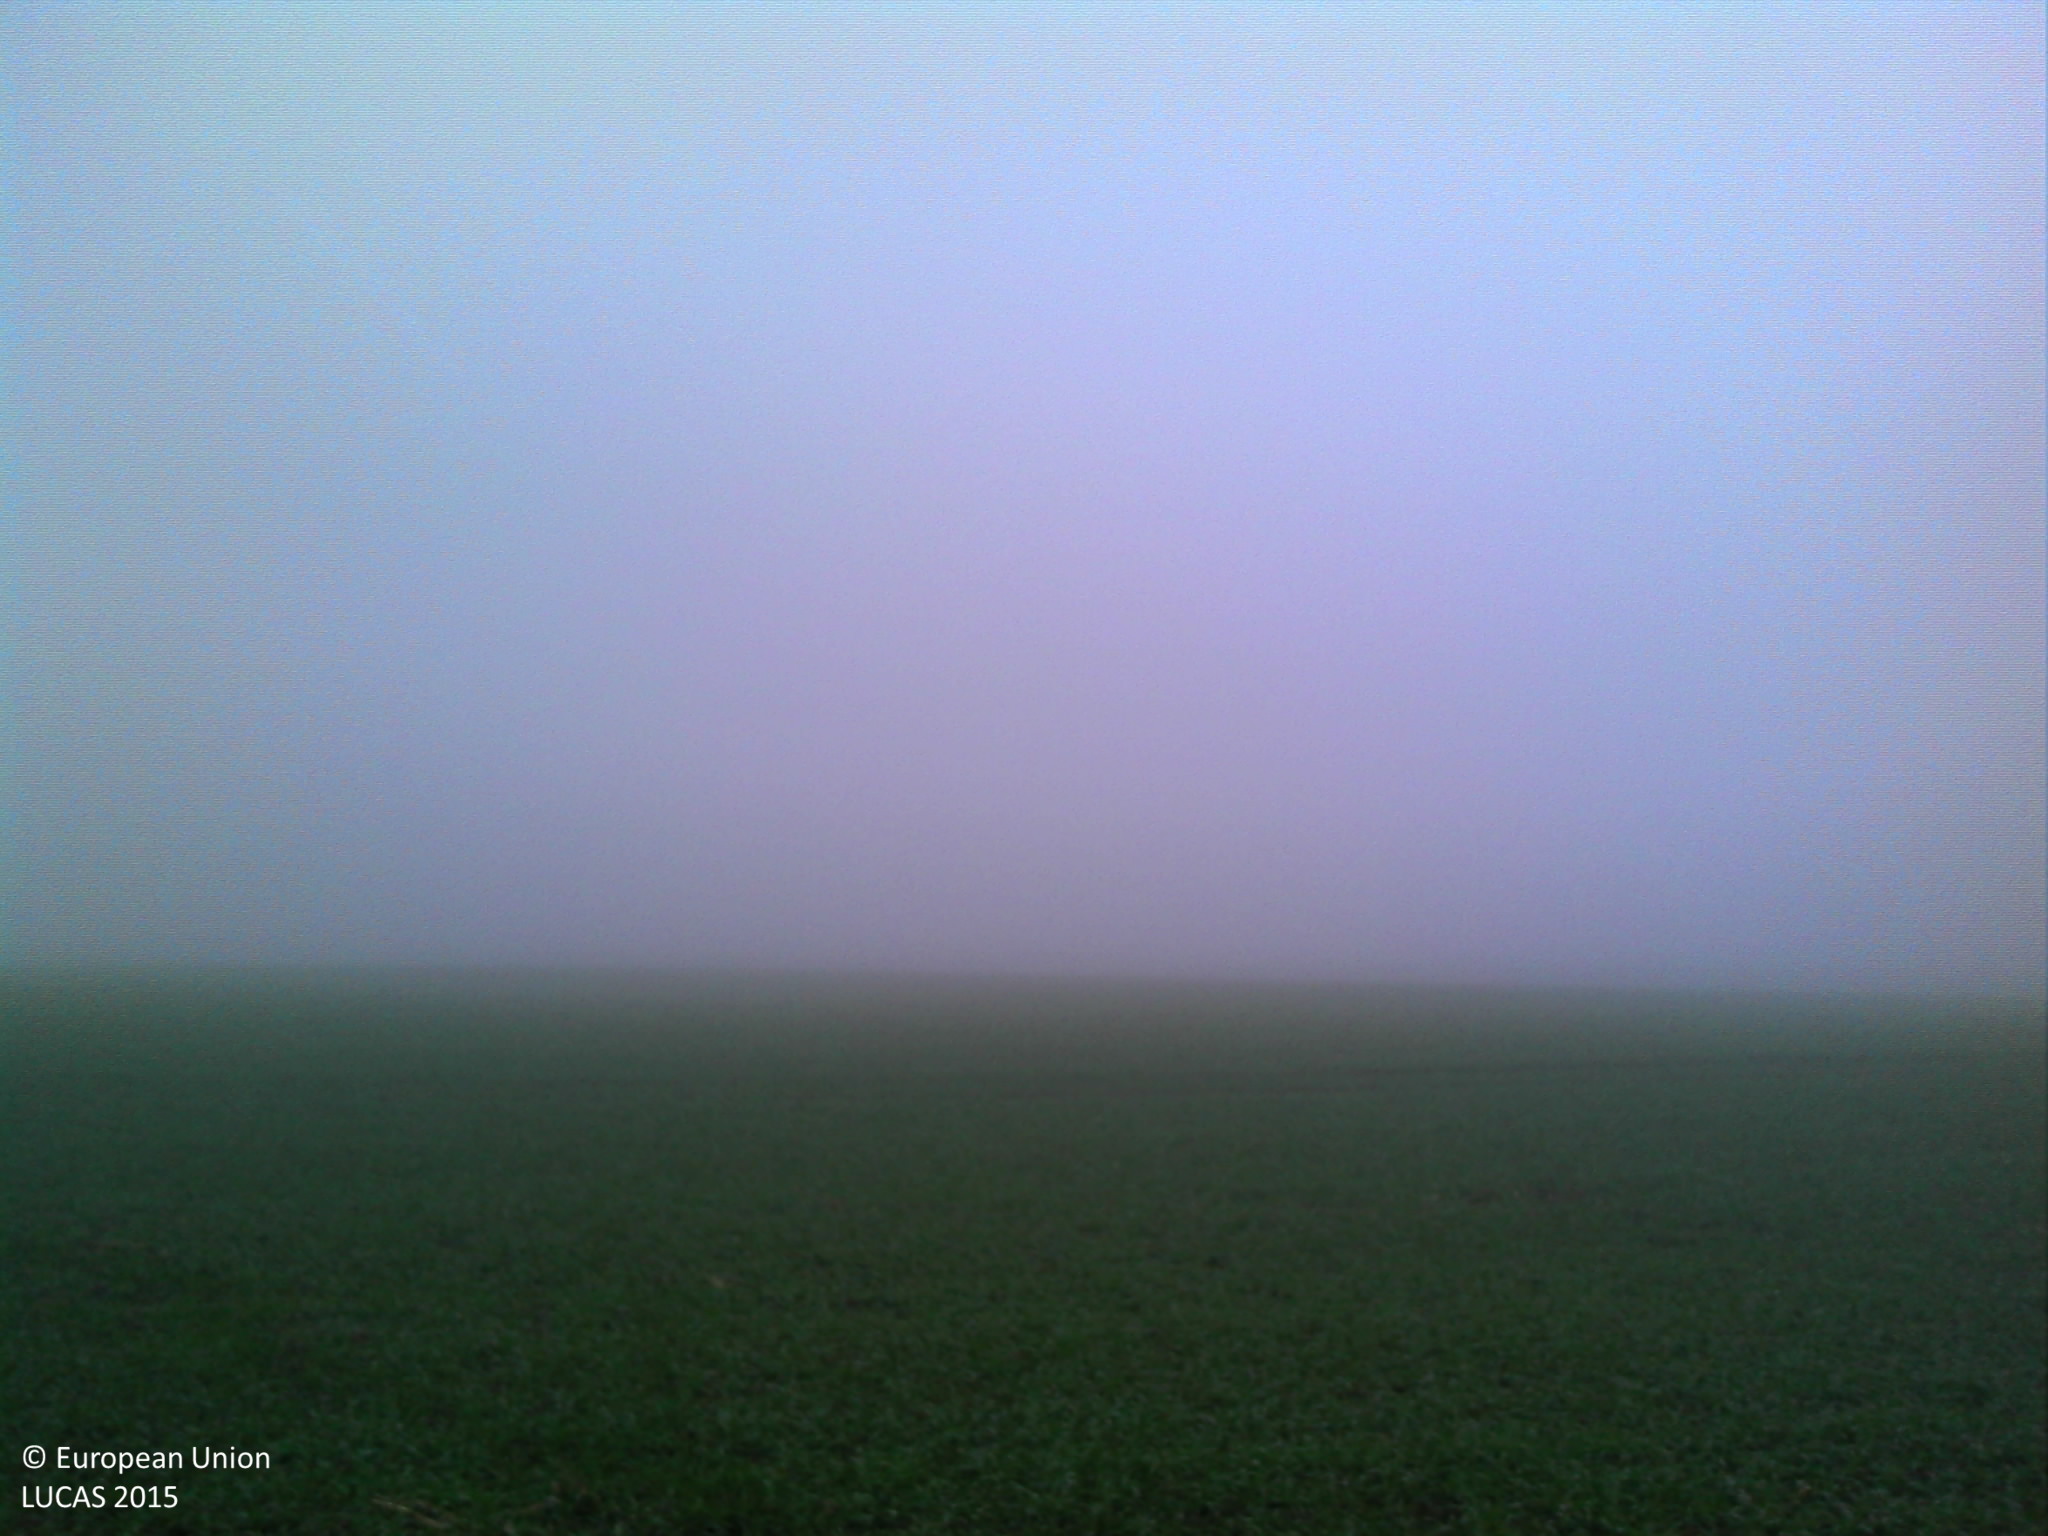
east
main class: Cropland
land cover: Common wheat
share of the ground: > 75 %
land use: Agriculture (excluding fallow land and kitchen gardens)
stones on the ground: < 10 %
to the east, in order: Common wheat; Ditches and canals; Common wheat; Grass margins; Ditches and canals; Broadleaved woodland
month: December
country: FR
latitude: 46.2396
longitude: 5.1137
